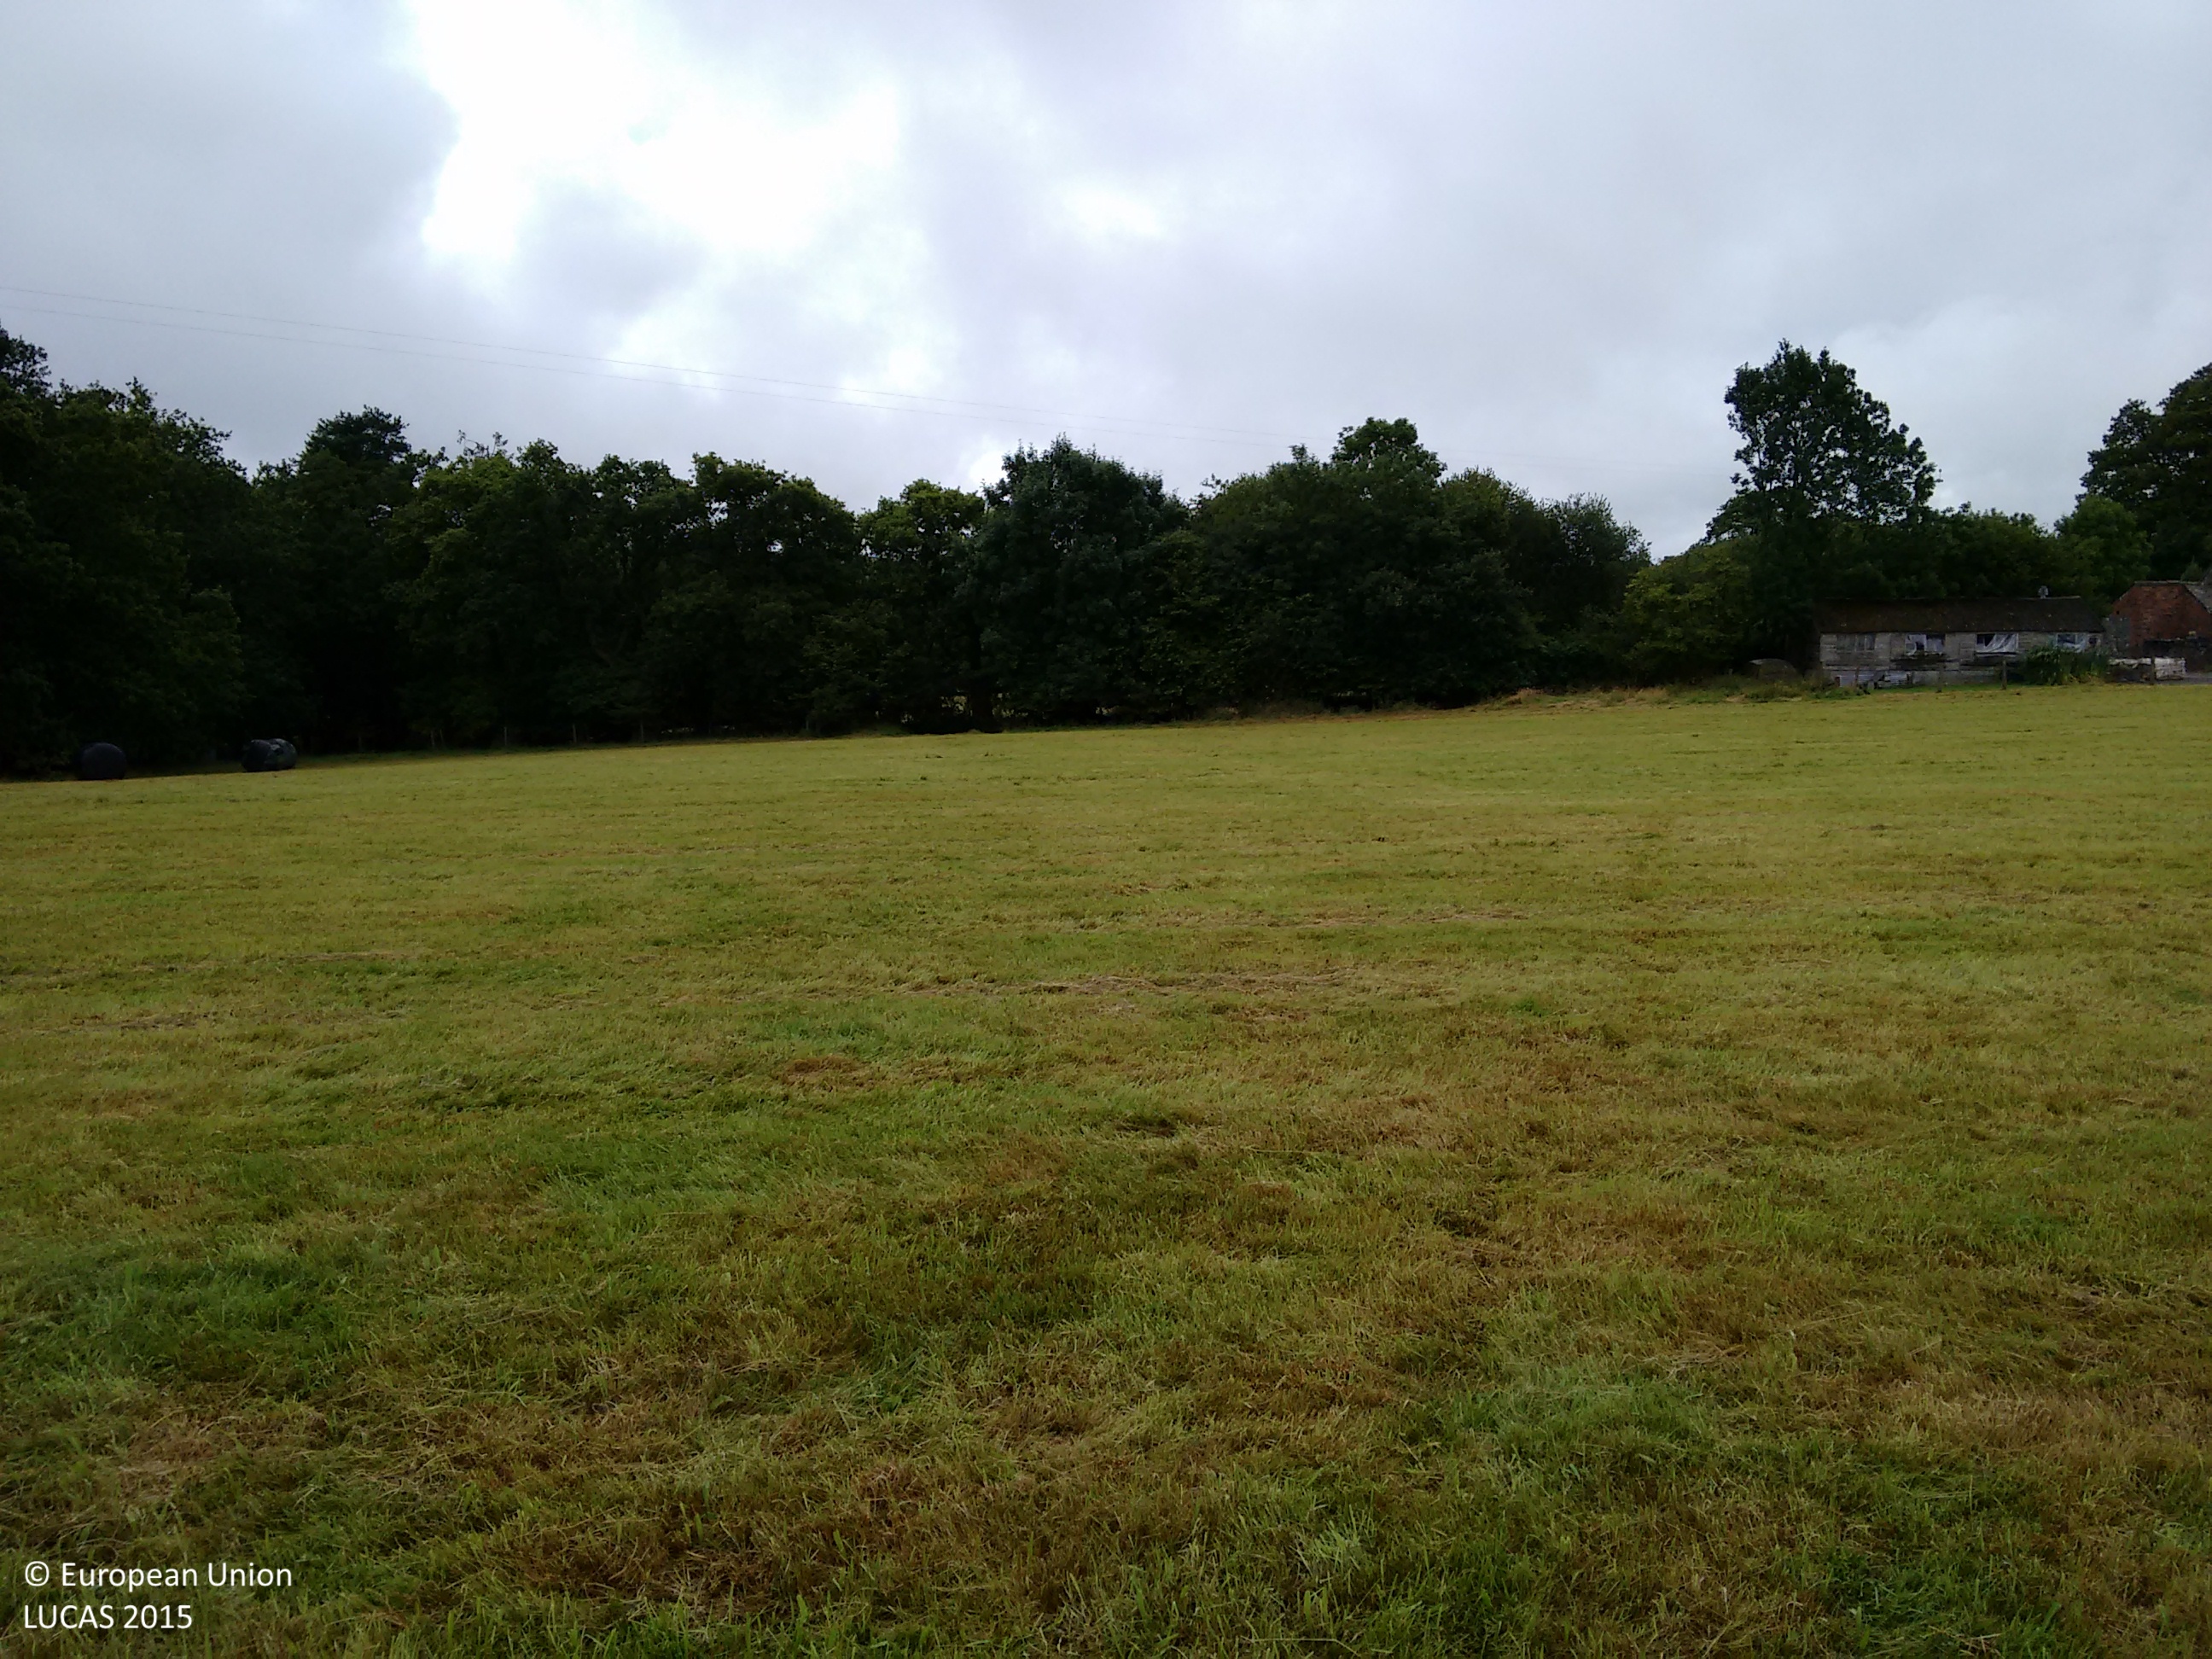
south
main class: Grassland
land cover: Grassland without tree/shrub cover
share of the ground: > 75 %
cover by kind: herbaceous plants 100 %
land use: Agriculture (excluding fallow land and kitchen gardens)
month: August
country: GB
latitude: 51.9034
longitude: -4.0339
